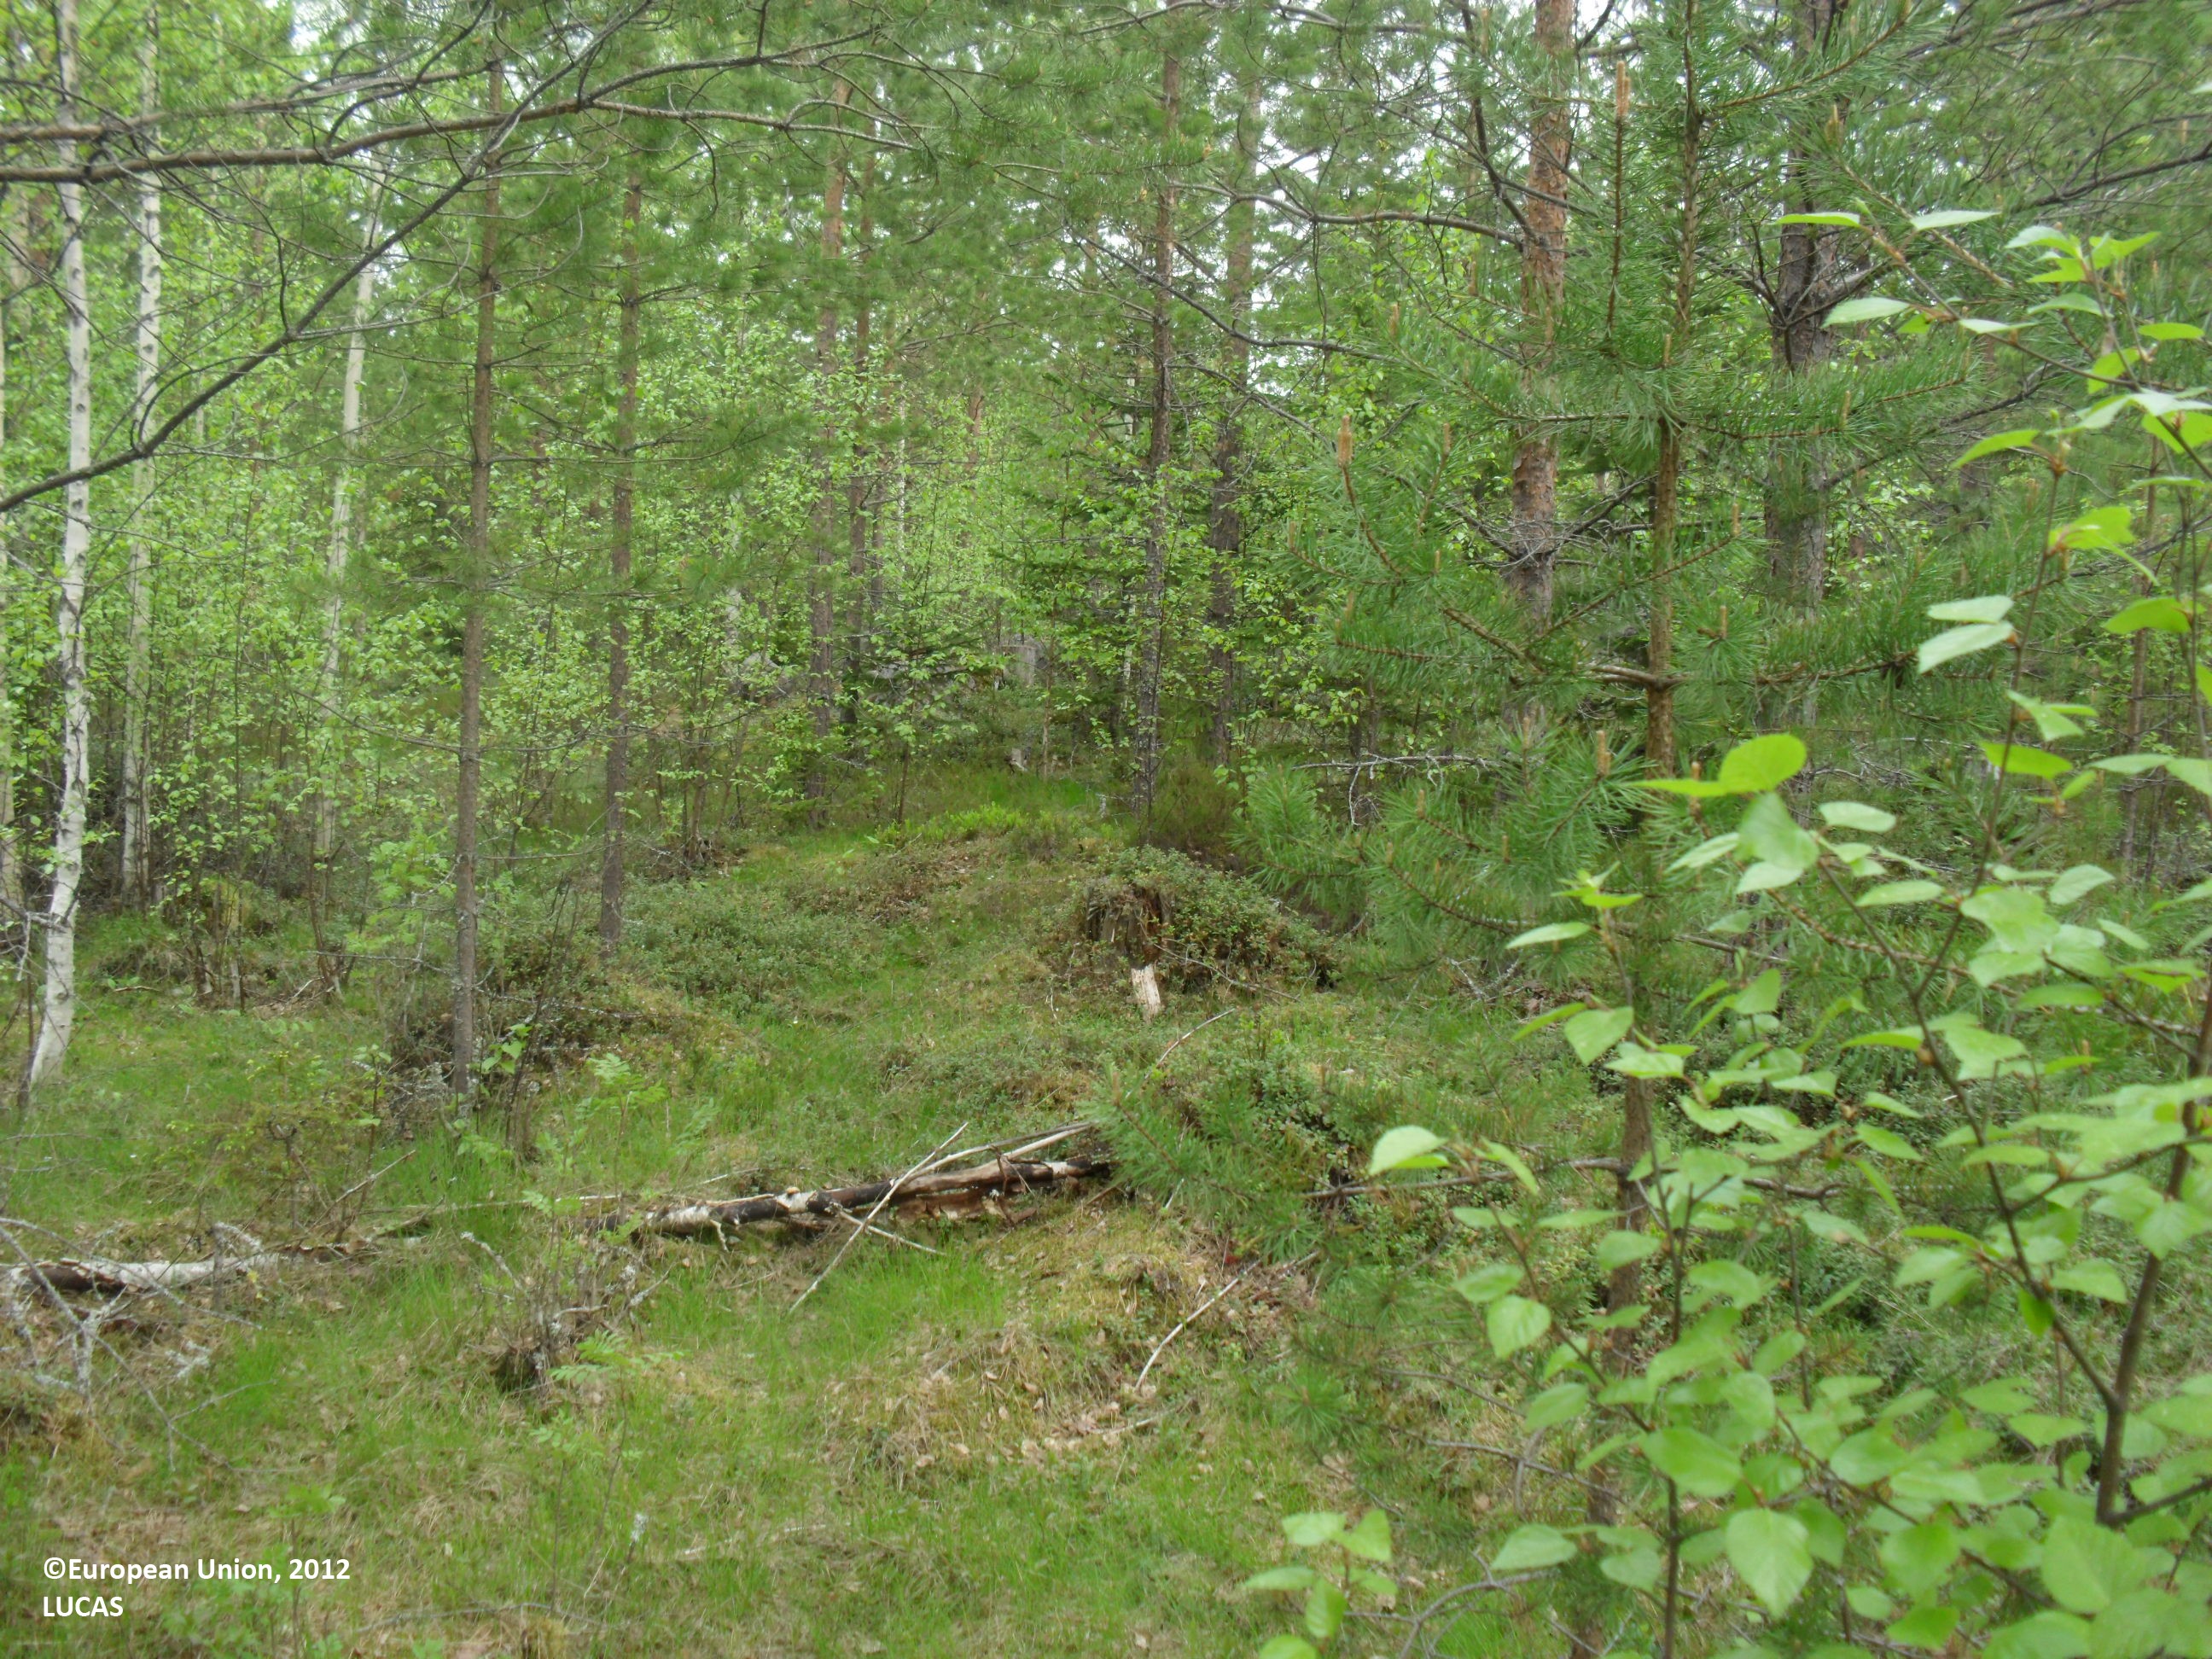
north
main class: Woodland
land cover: Pine dominated mixed woodland
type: boreal forest
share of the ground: 50 - 75 %
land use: Forestry
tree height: > 5 m
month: June
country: FI
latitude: 63.0172
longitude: 22.9982
